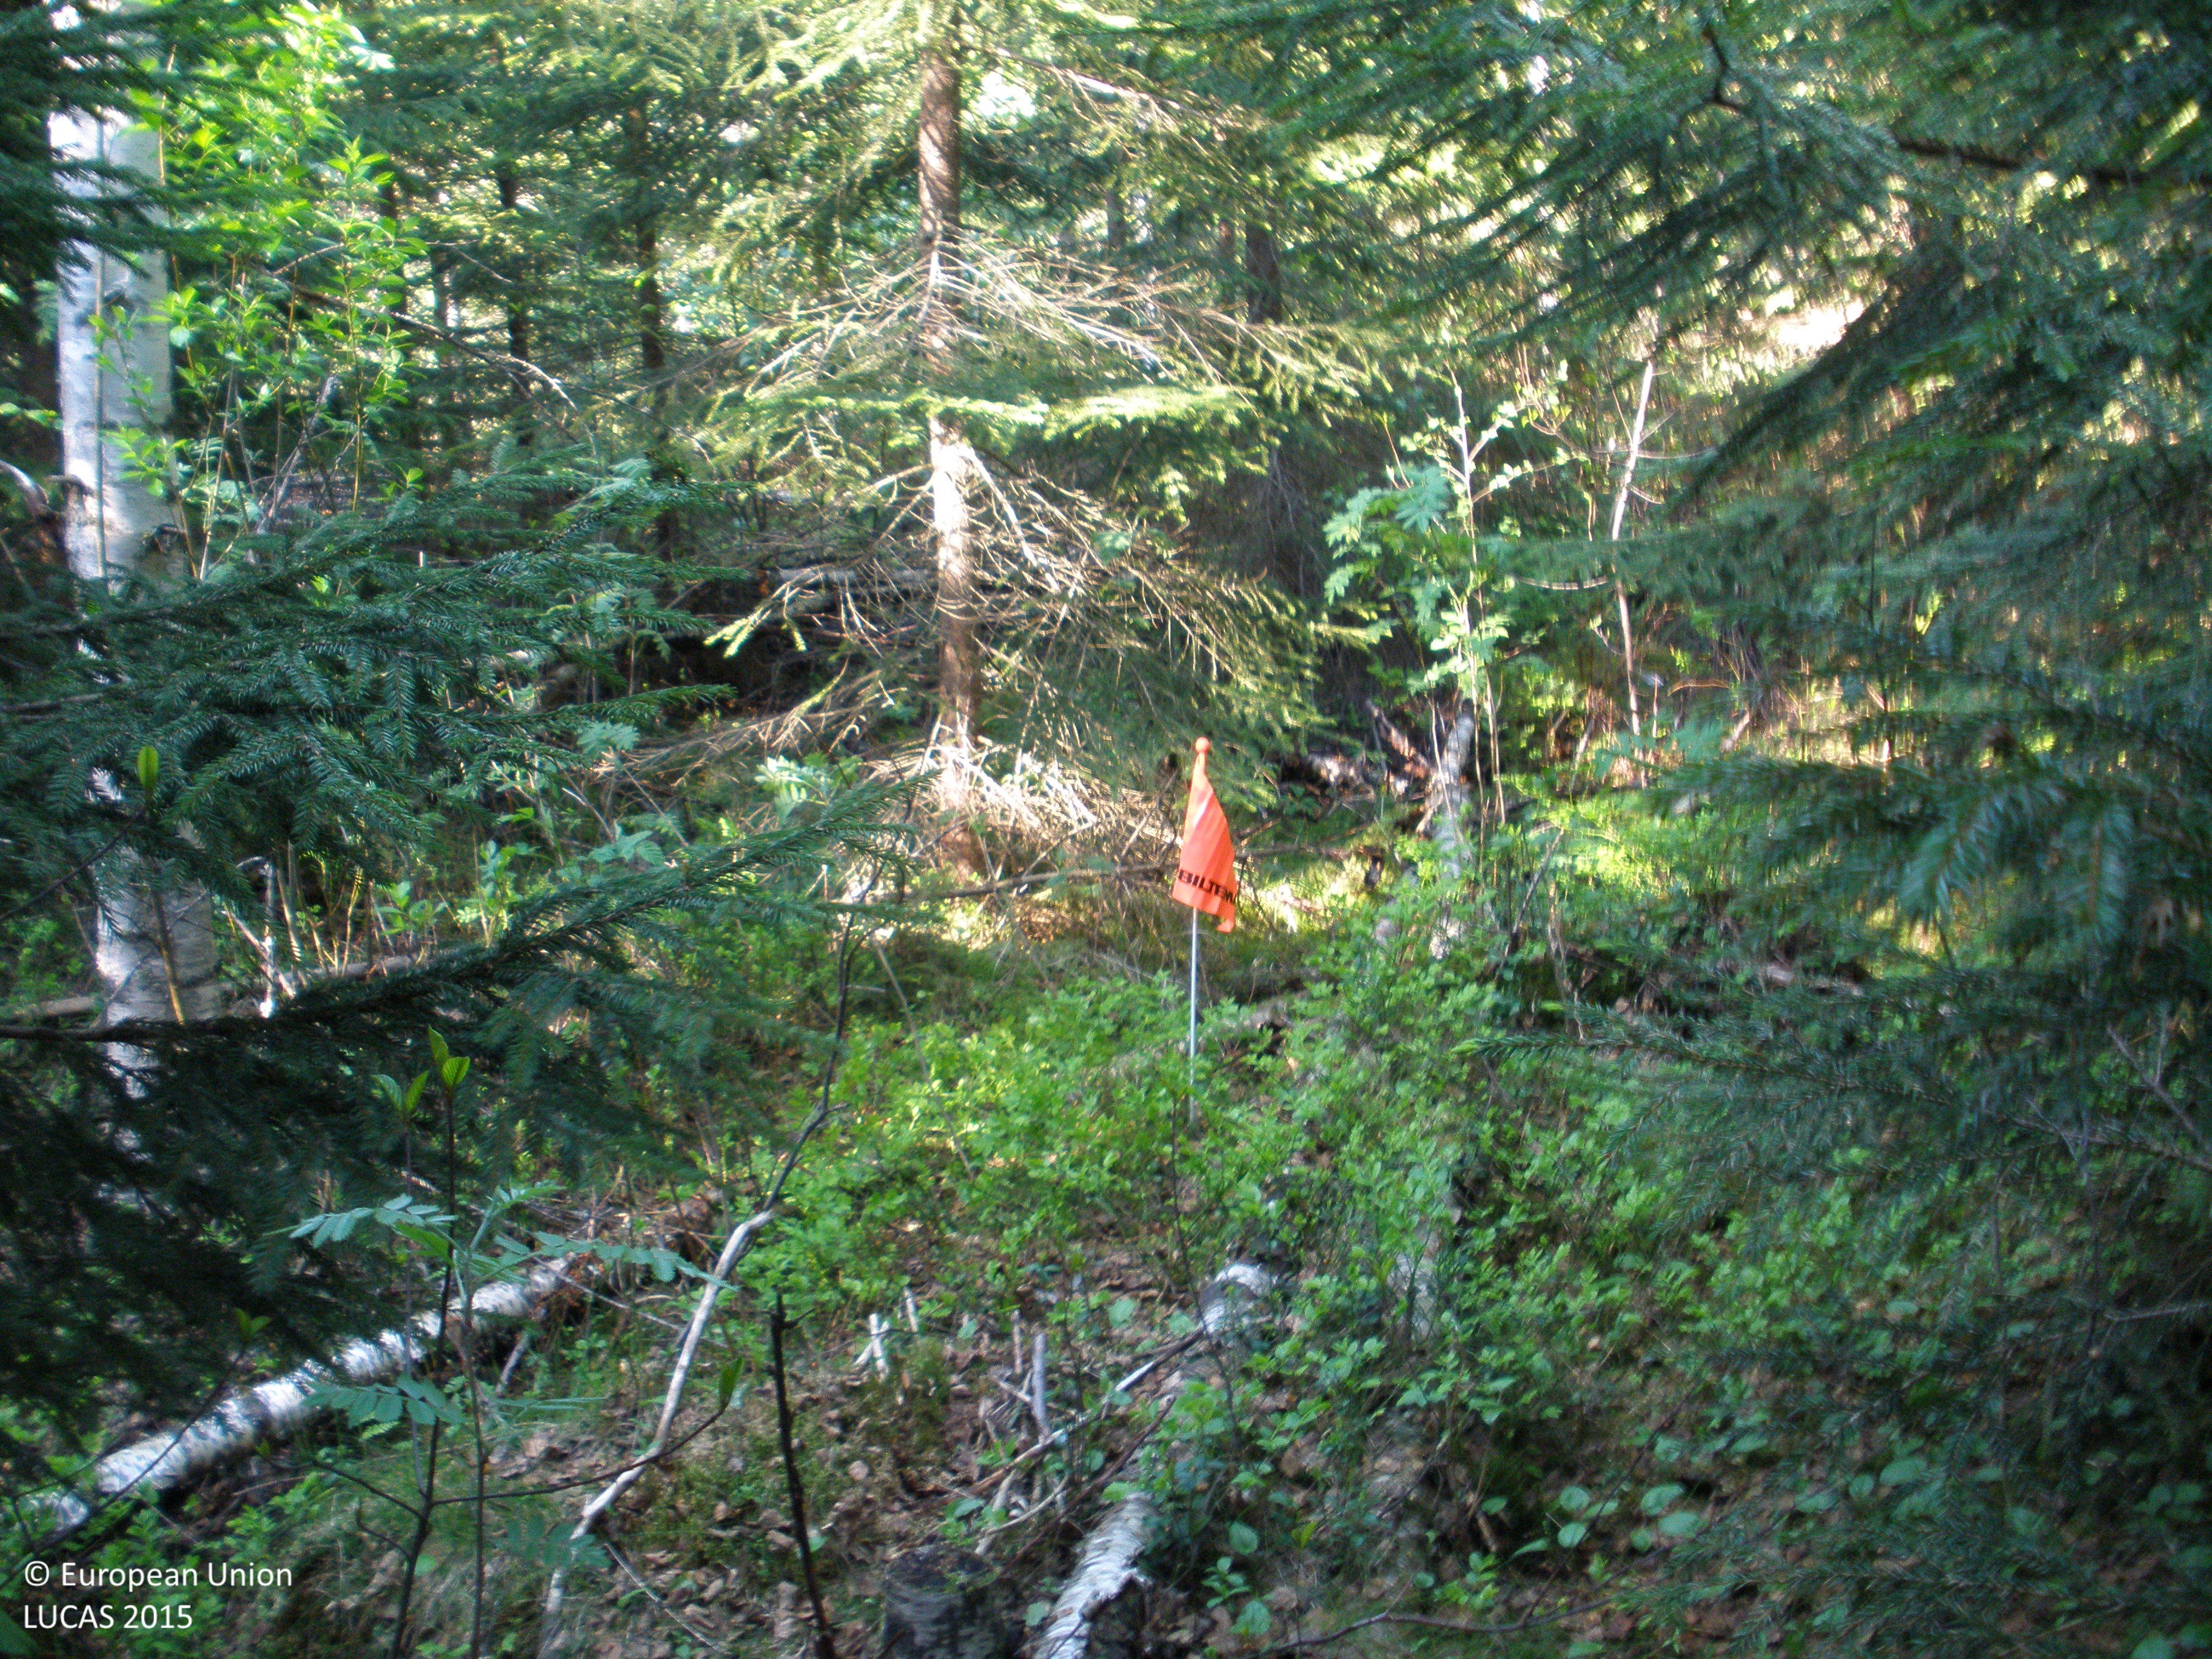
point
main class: Woodland
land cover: Spruce dominated coniferous woodland
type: boreal forest
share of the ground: > 75 %
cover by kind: coniferous forest trees 80 %, broadleaved forest trees 10 %, herbaceous plants 10 %
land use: Forestry
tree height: > 5 m
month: June
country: FI
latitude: 60.7690
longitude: 24.1031
